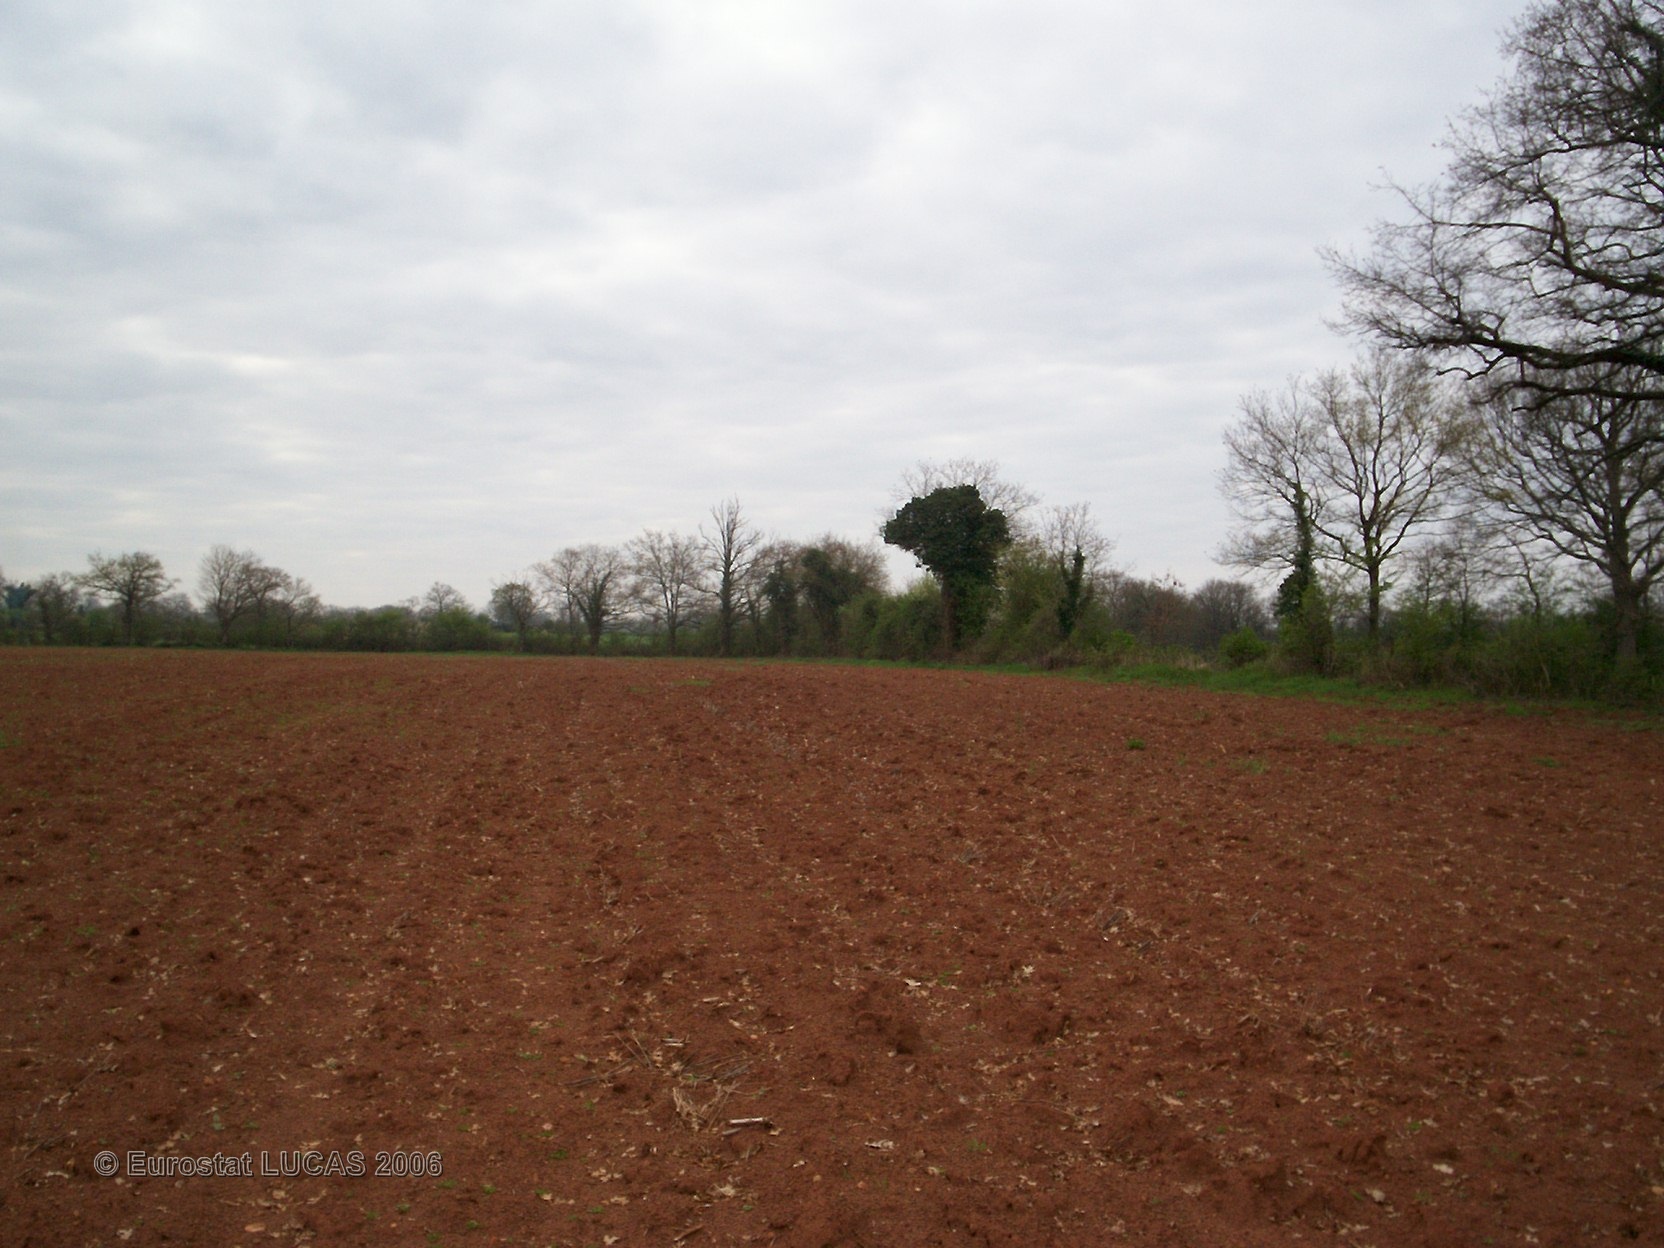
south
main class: Cropland
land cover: Maize
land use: Agriculture (excluding fallow land and kitchen gardens)
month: May
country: FR
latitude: 46.1313
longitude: 0.5490
